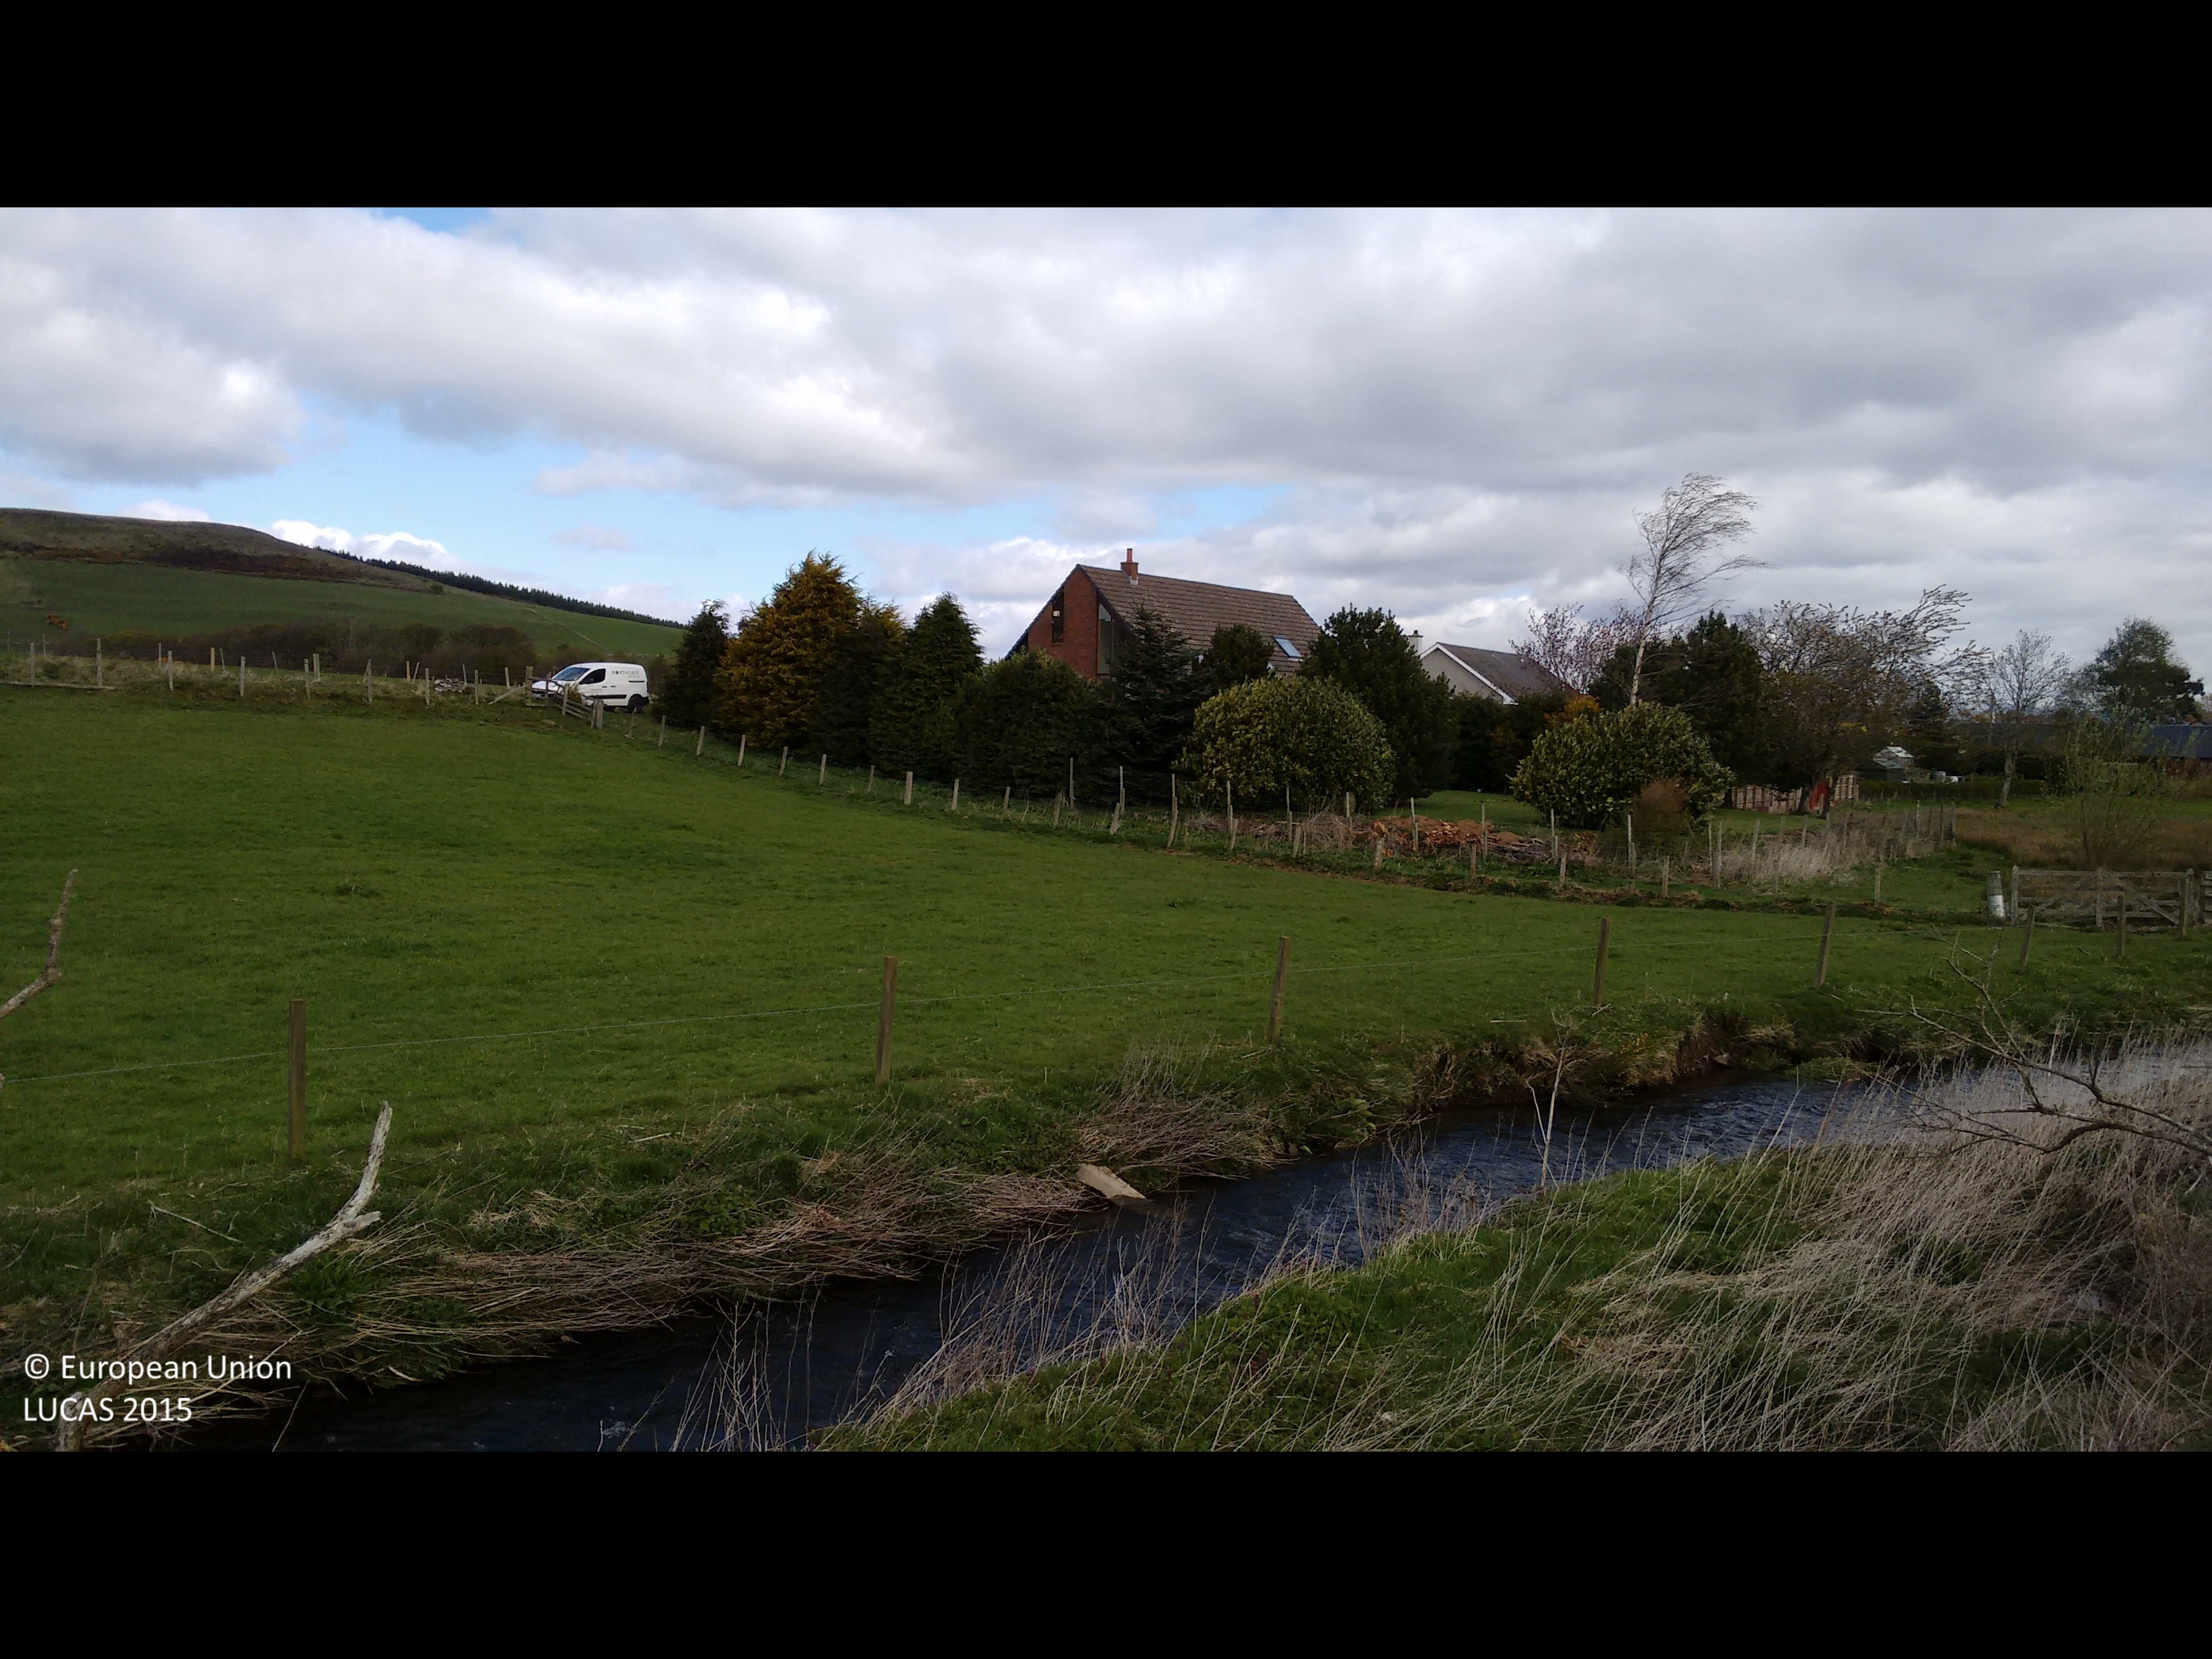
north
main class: Shrubland
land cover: Shrubland without tree cover
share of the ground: 50 - 75 %
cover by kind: herbaceous plants 60 %, shrubs 40 %
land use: Semi-natural and natural areas not in use
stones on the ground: 10 - 25 %
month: May
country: GB
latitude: 56.5800
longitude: -3.0079
